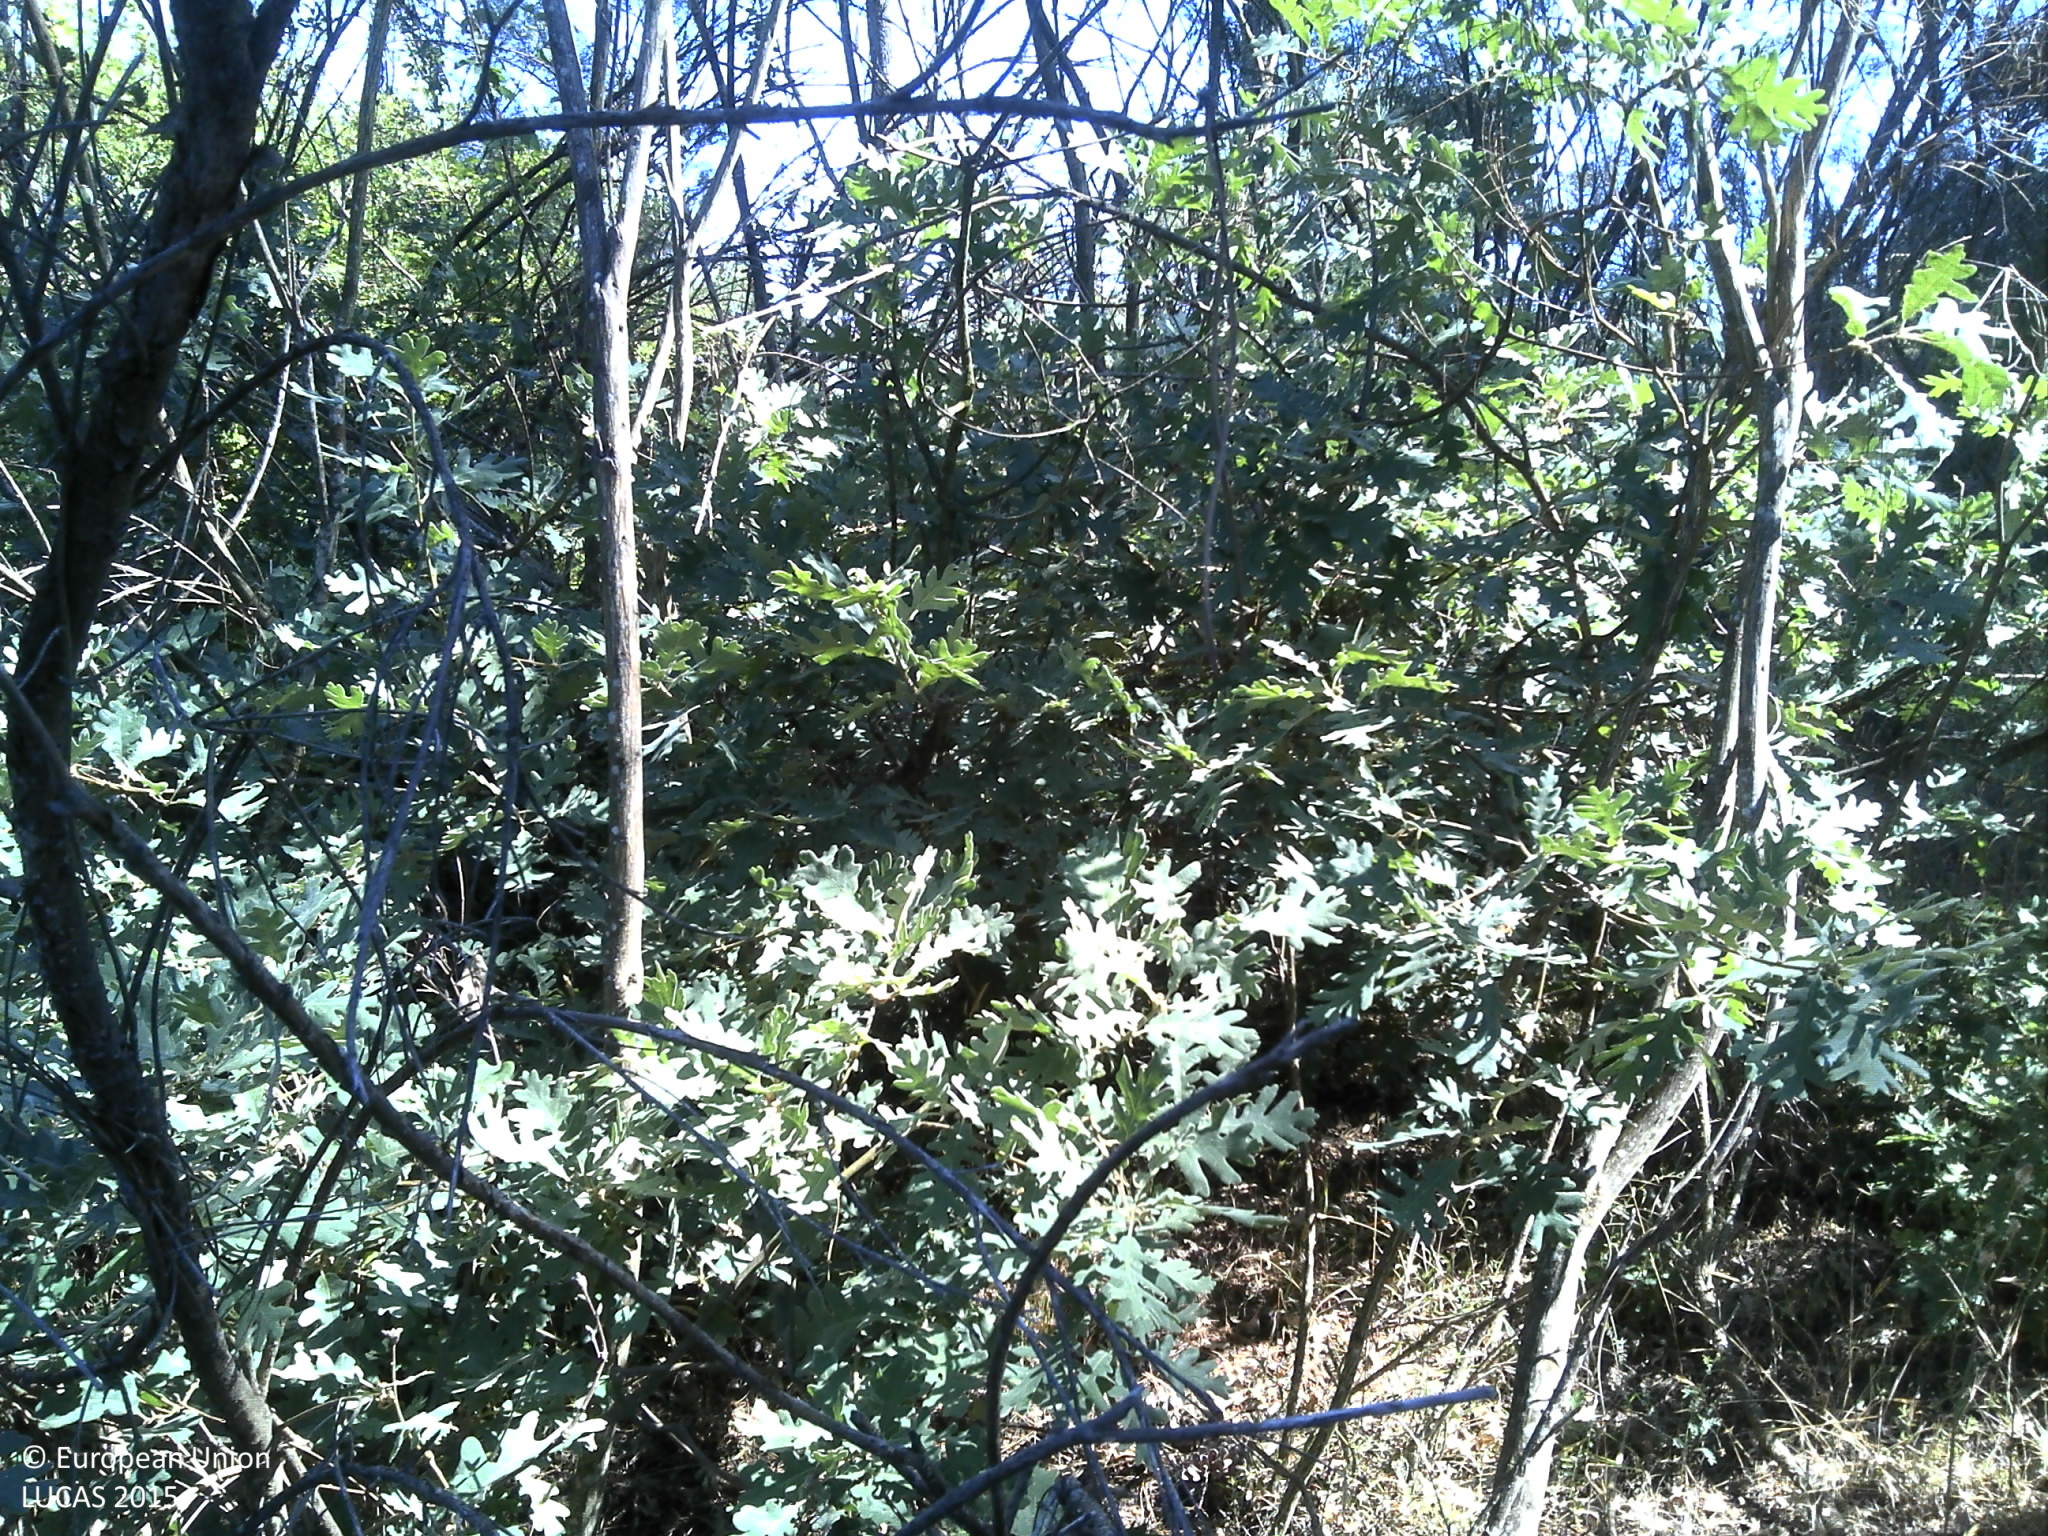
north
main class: Woodland
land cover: Pine dominated mixed woodland
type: coniferous forest of the mediterranean region
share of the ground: 50 - 75 %
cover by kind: shrubs 50 %, coniferous forest trees 30 %, broadleaved forest trees 10 %, unconsolidated bare surface 10 %
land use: Forestry
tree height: > 5 m
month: June
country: PT
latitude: 40.7597
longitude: -7.2253
